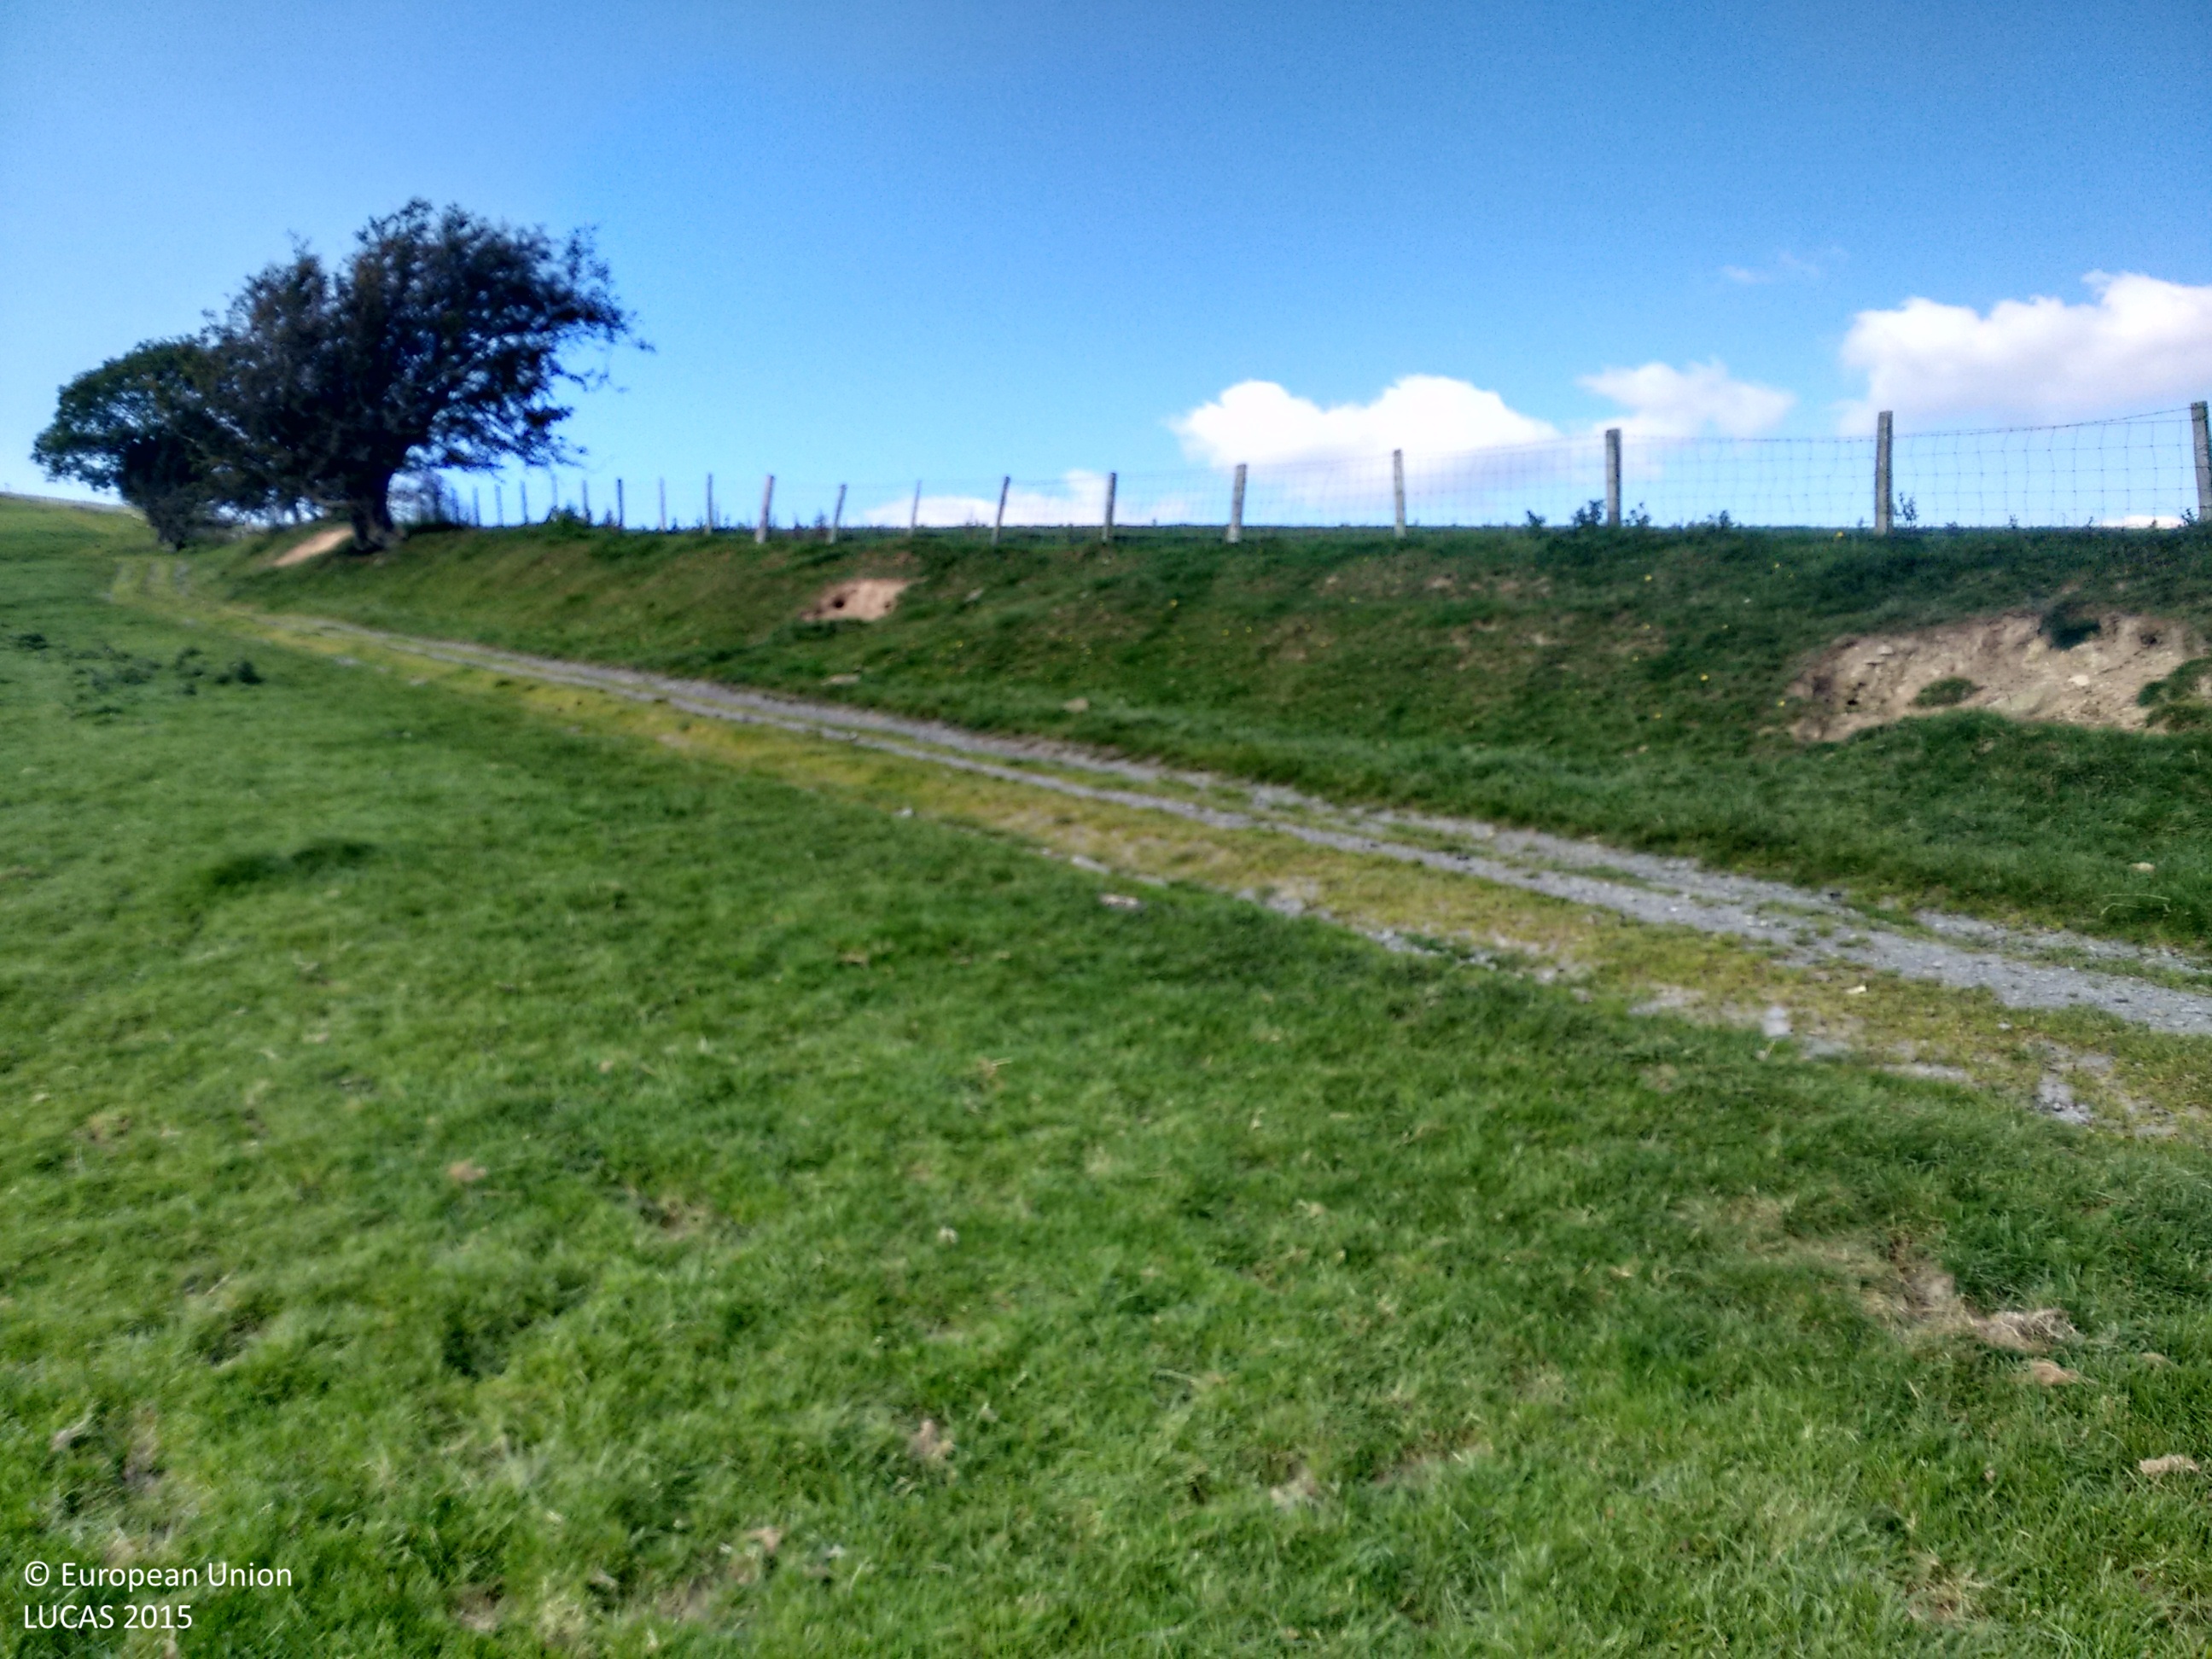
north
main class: Grassland
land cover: Grassland without tree/shrub cover
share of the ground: > 75 %
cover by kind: herbaceous plants 100 %
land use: Agriculture (excluding fallow land and kitchen gardens)
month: September
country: GB
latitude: 52.6260
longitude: -3.6339
